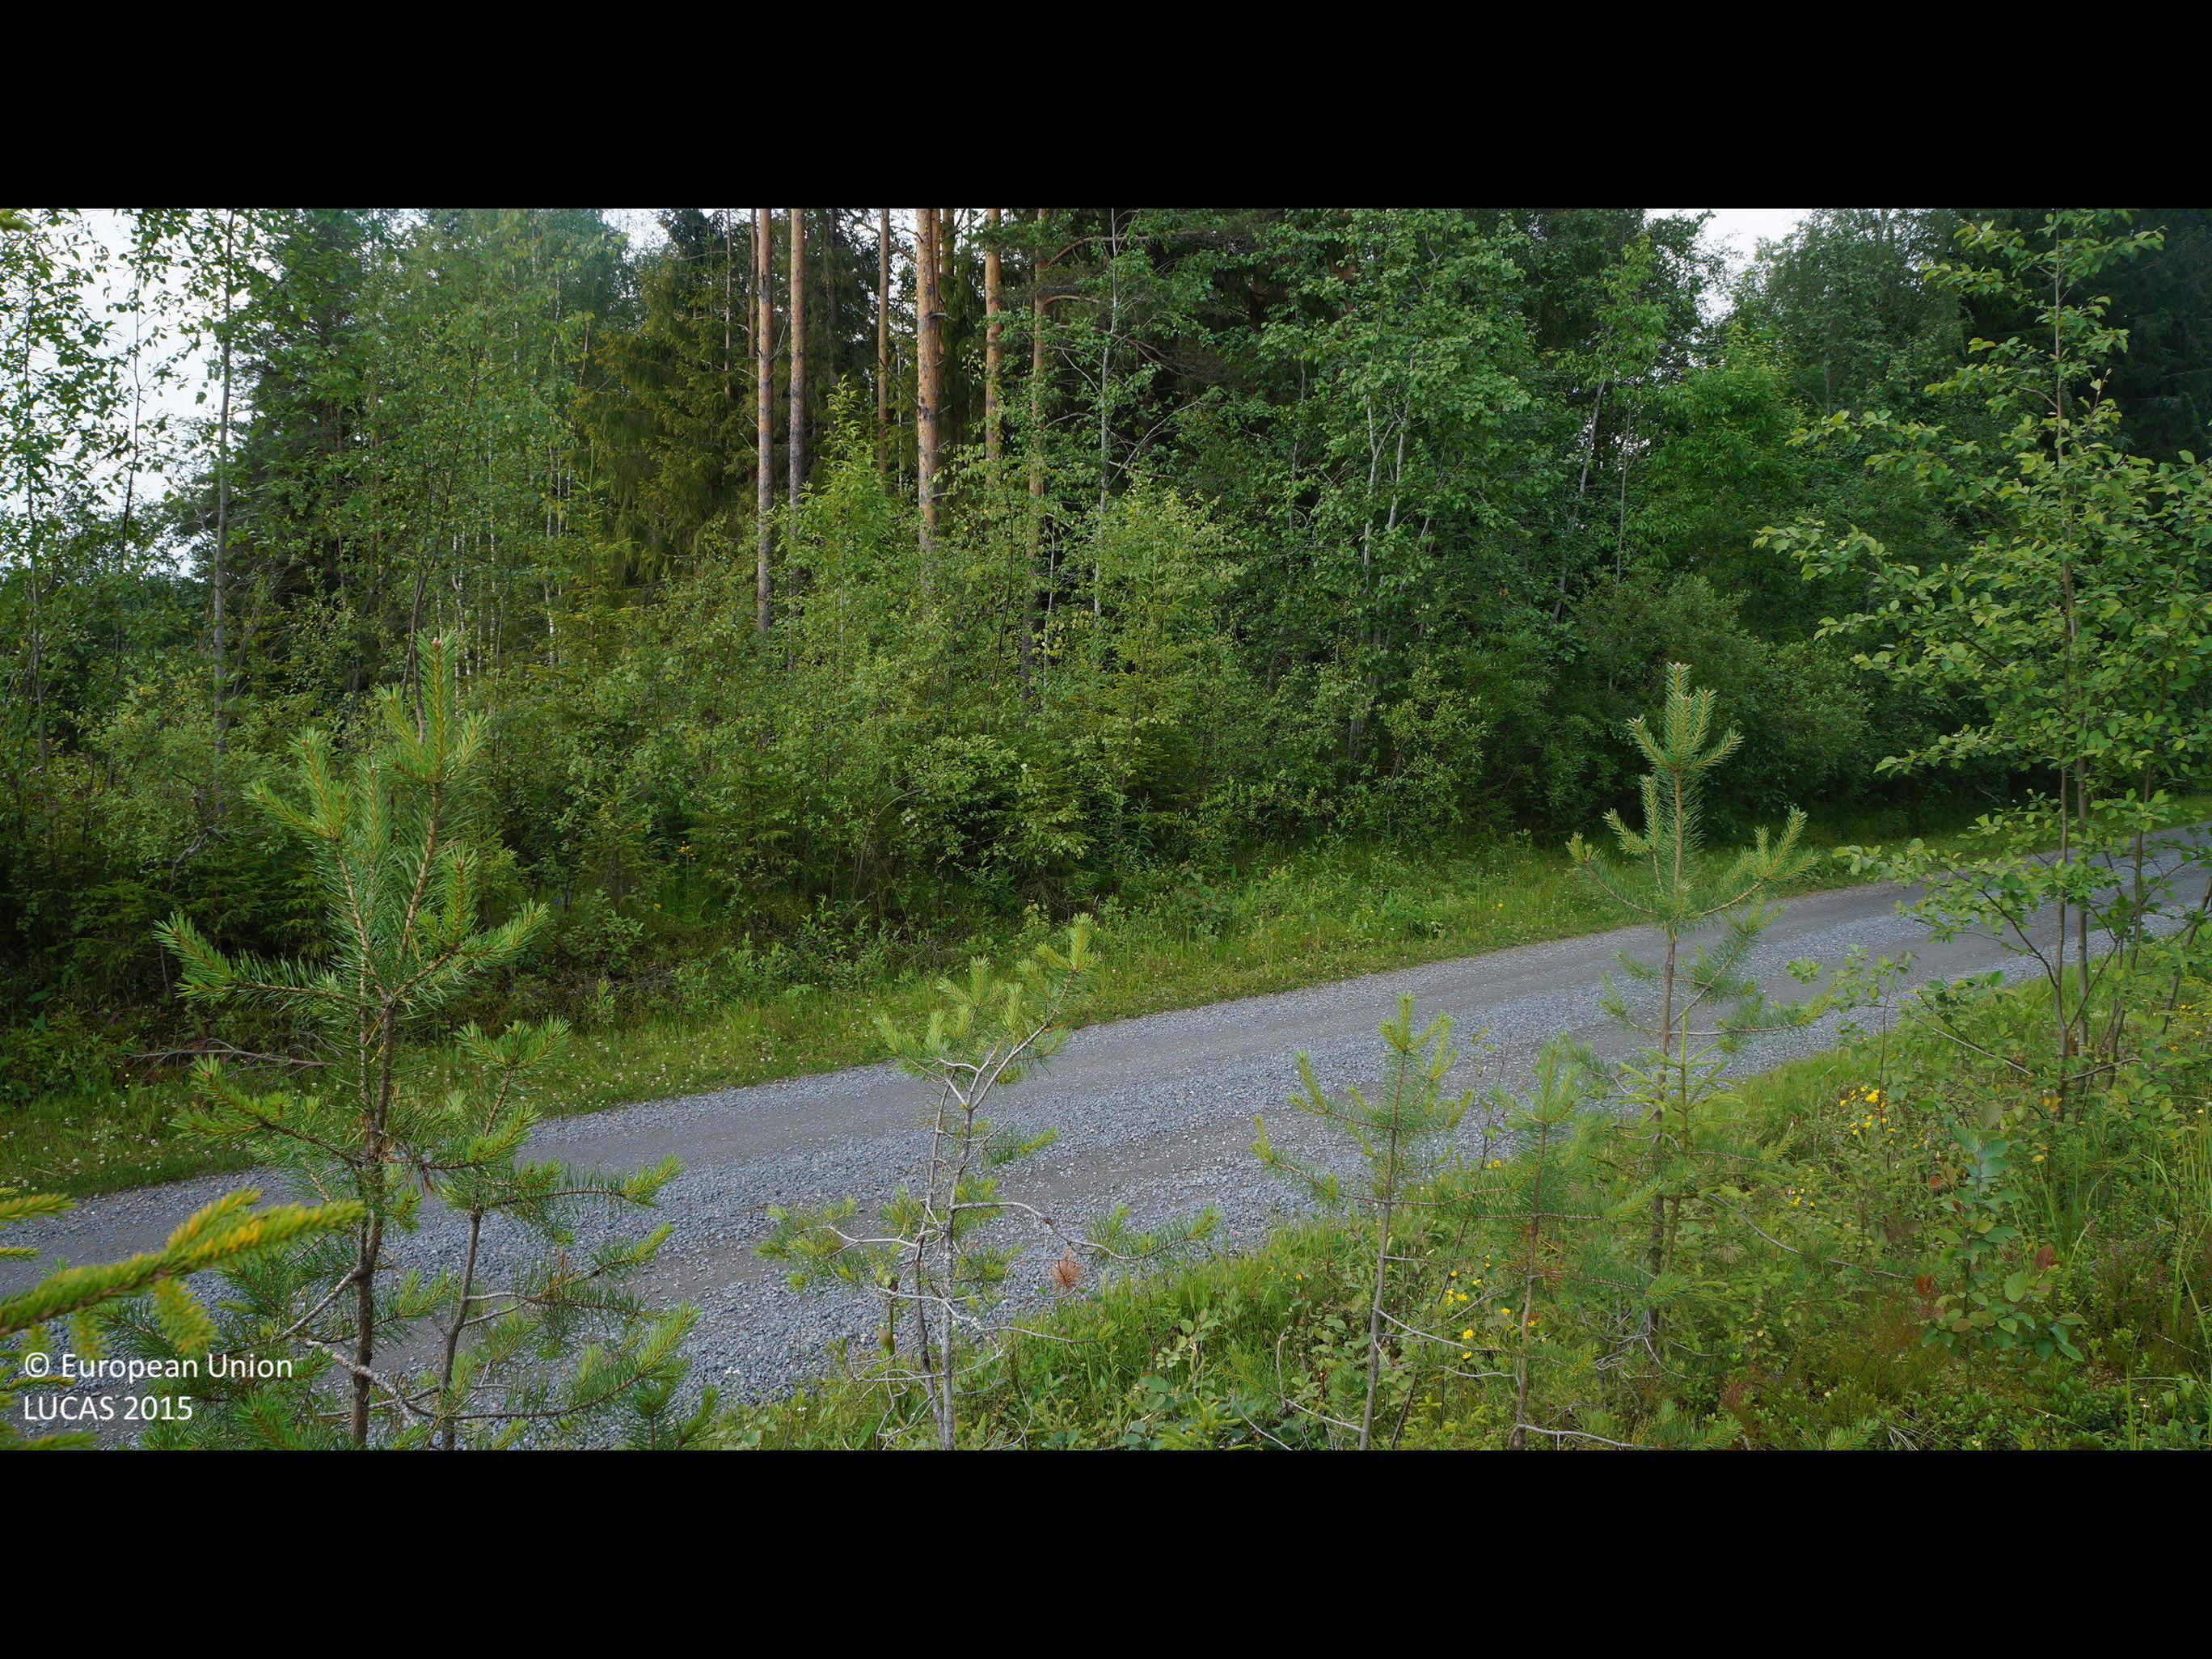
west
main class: Woodland
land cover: Pine dominated coniferous woodland
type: boreal forest
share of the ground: 10 - 25 %
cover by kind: shrubs 80 %, coniferous forest trees 10 %, herbaceous plants 5 %, lichens and mosses 5 %
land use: Forestry
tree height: > 5 m
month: July
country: FI
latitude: 64.1110
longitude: 24.3368
